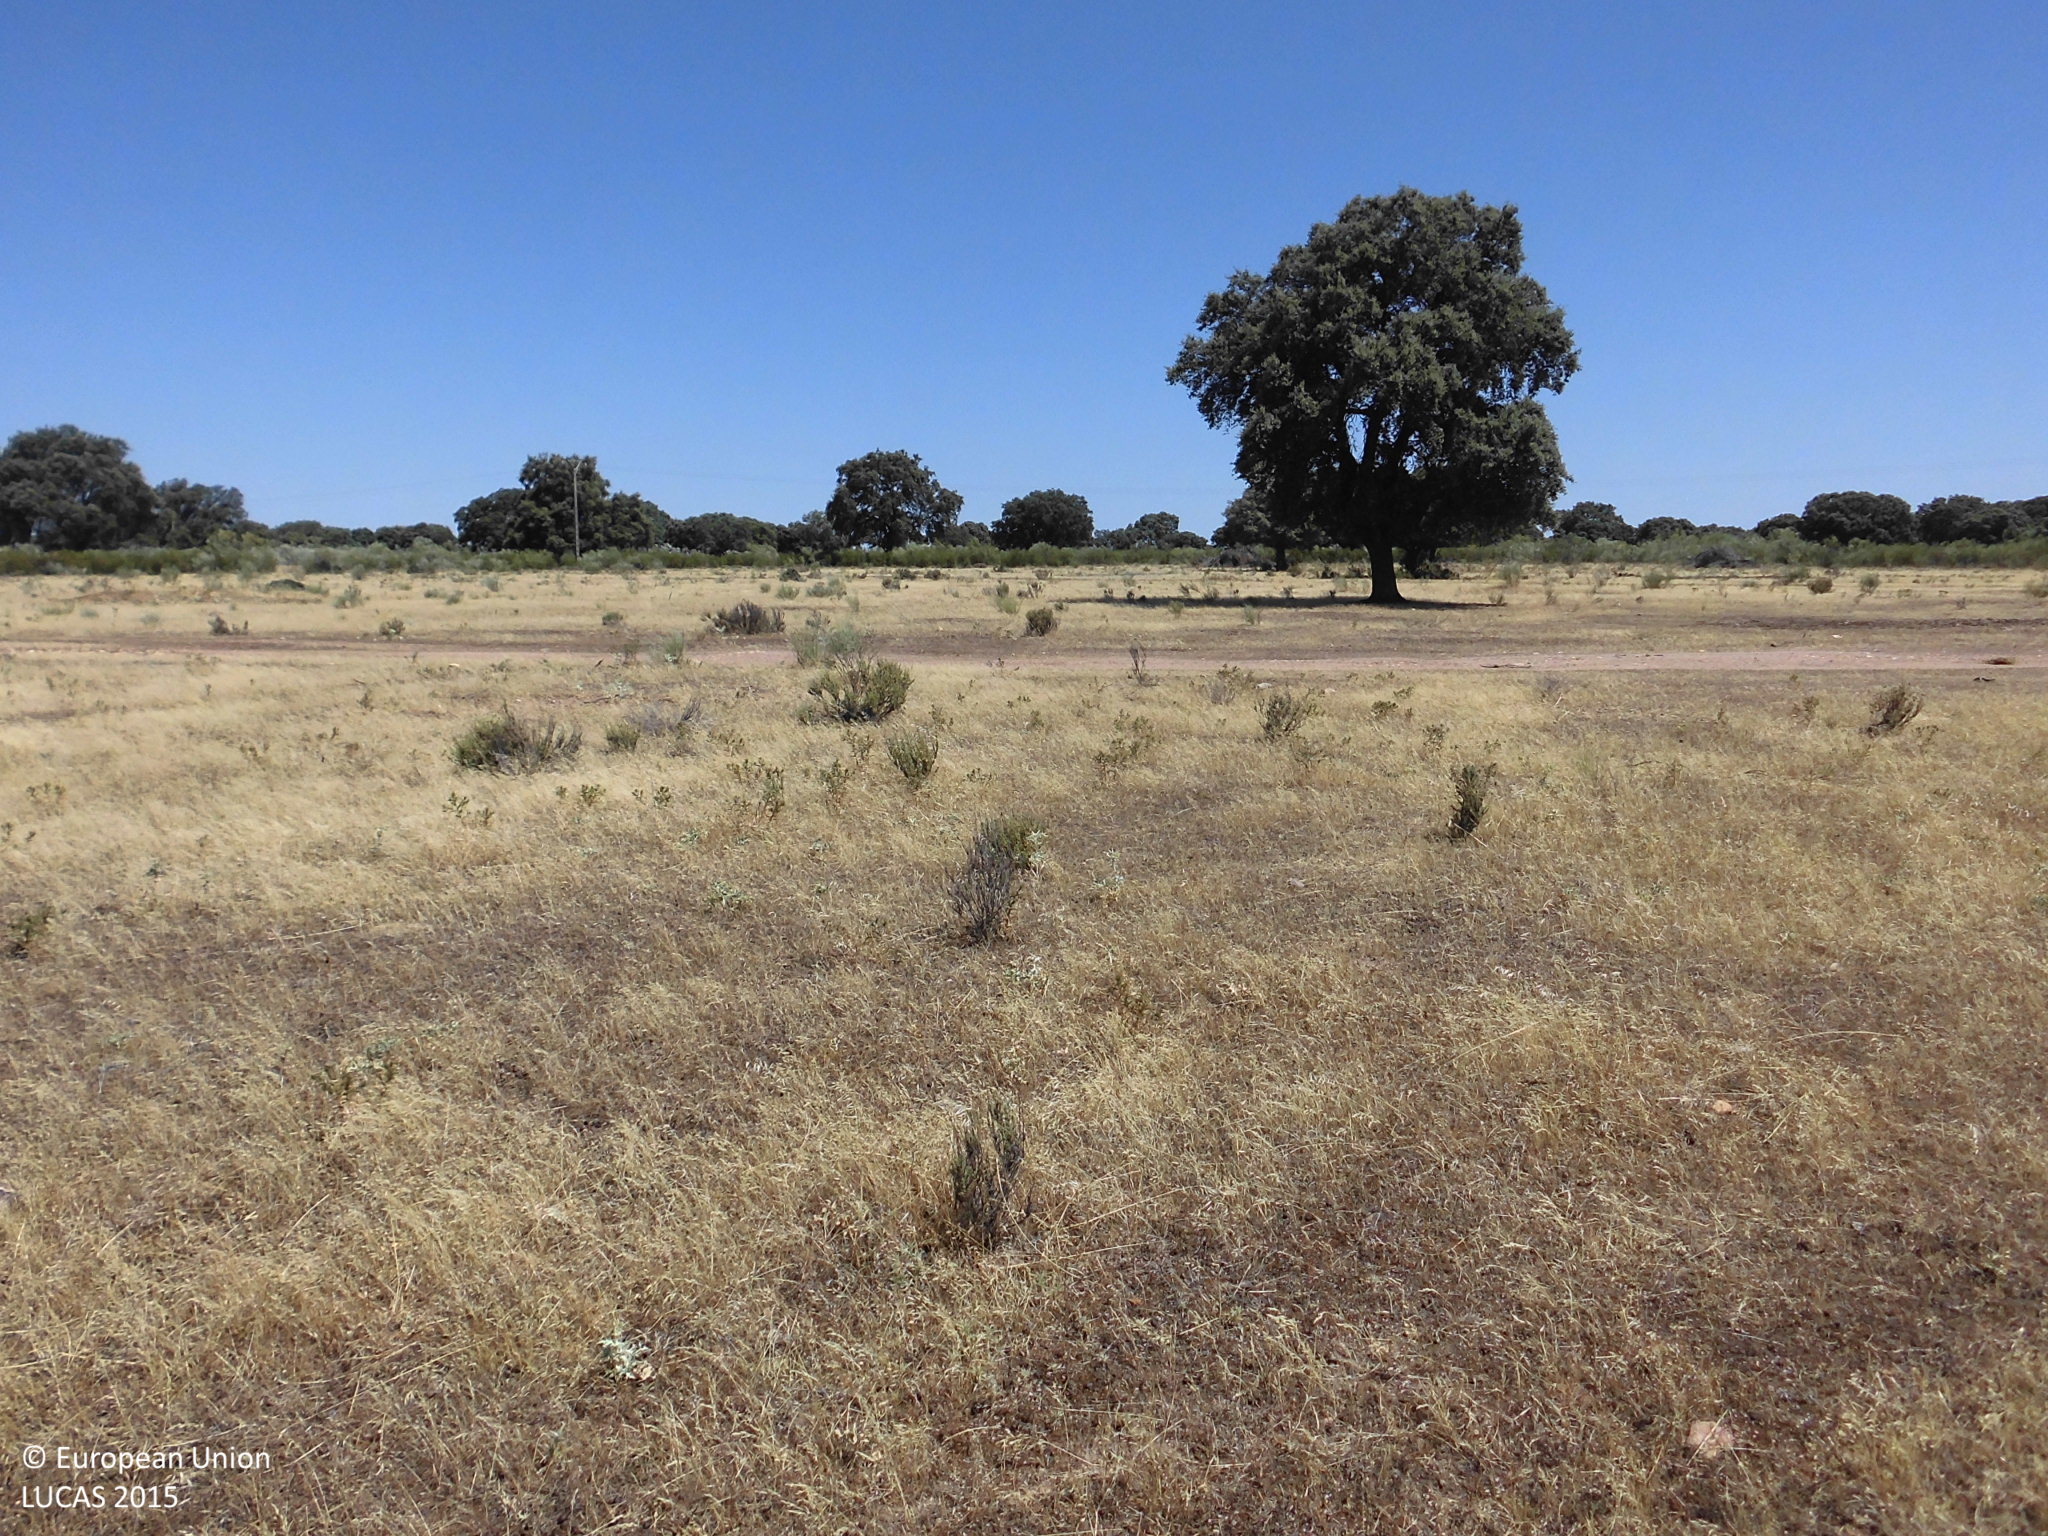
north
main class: Grassland
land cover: Grassland without tree/shrub cover
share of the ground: > 75 %
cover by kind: herbaceous plants 100 %
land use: Agriculture (excluding fallow land and kitchen gardens)
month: June
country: ES
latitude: 39.7056
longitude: -5.9609
